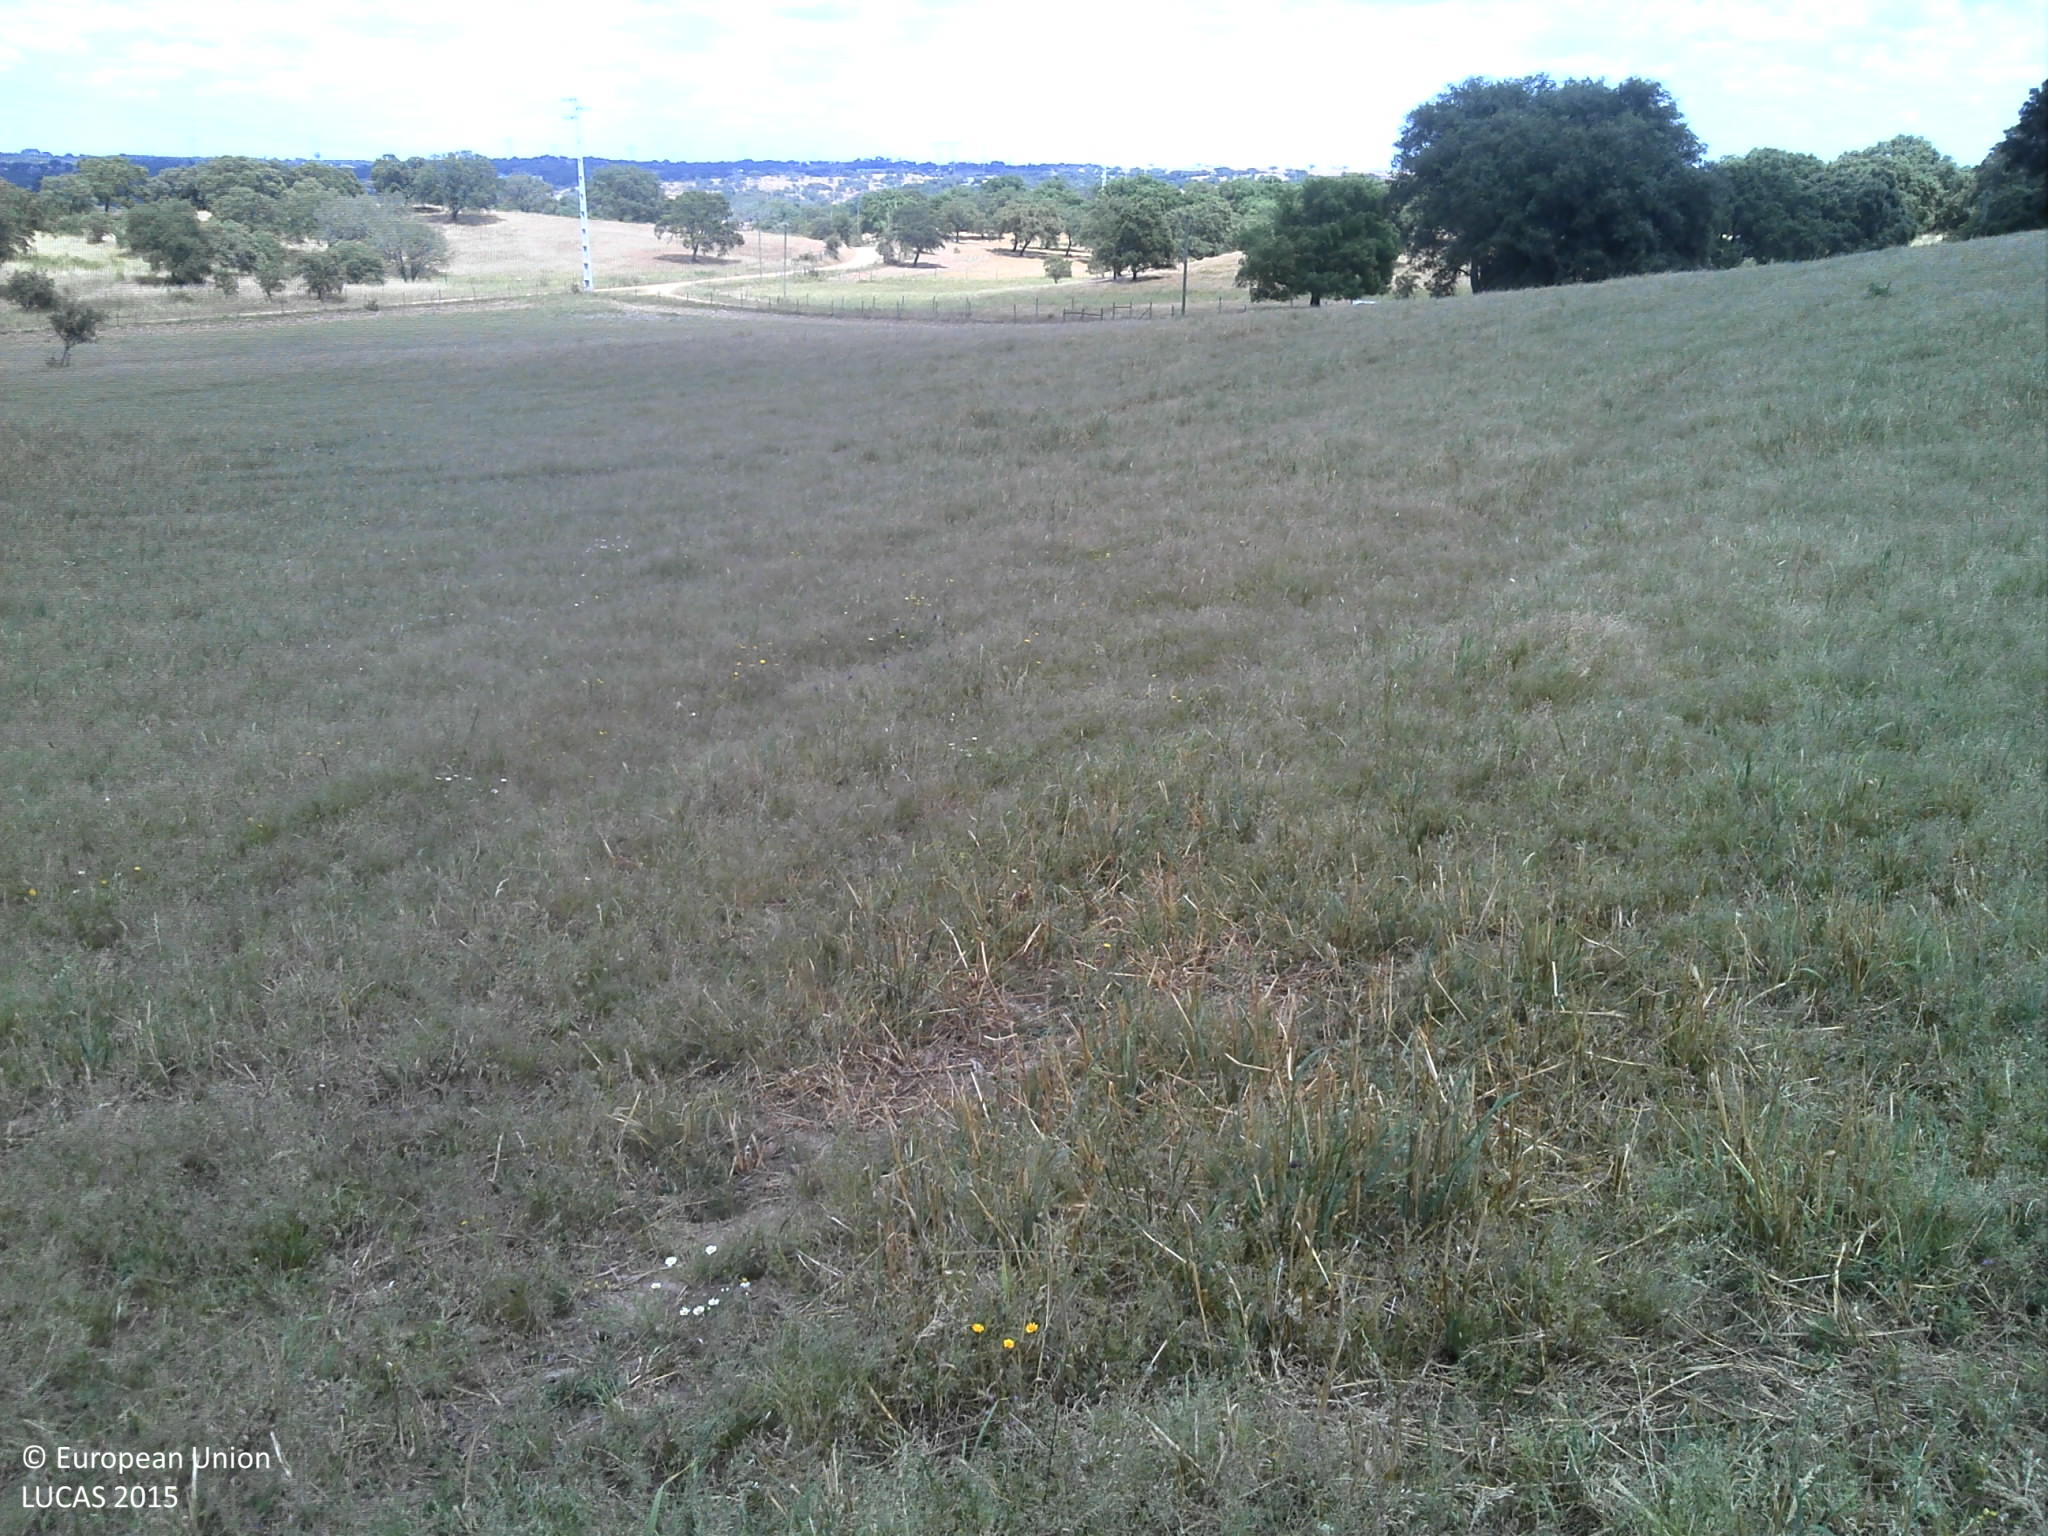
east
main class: Grassland
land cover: Grassland without tree/shrub cover
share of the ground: 50 - 75 %
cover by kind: herbaceous plants 70 %, unconsolidated bare surface 30 %
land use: Agriculture (excluding fallow land and kitchen gardens)
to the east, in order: Grassland without tree/shrub cover; Other structural elements; Fences; Tracks; Electric lines; Fences; Other structural elements; Broadleaved woodland
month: May
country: PT
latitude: 37.9950
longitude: -8.5717
